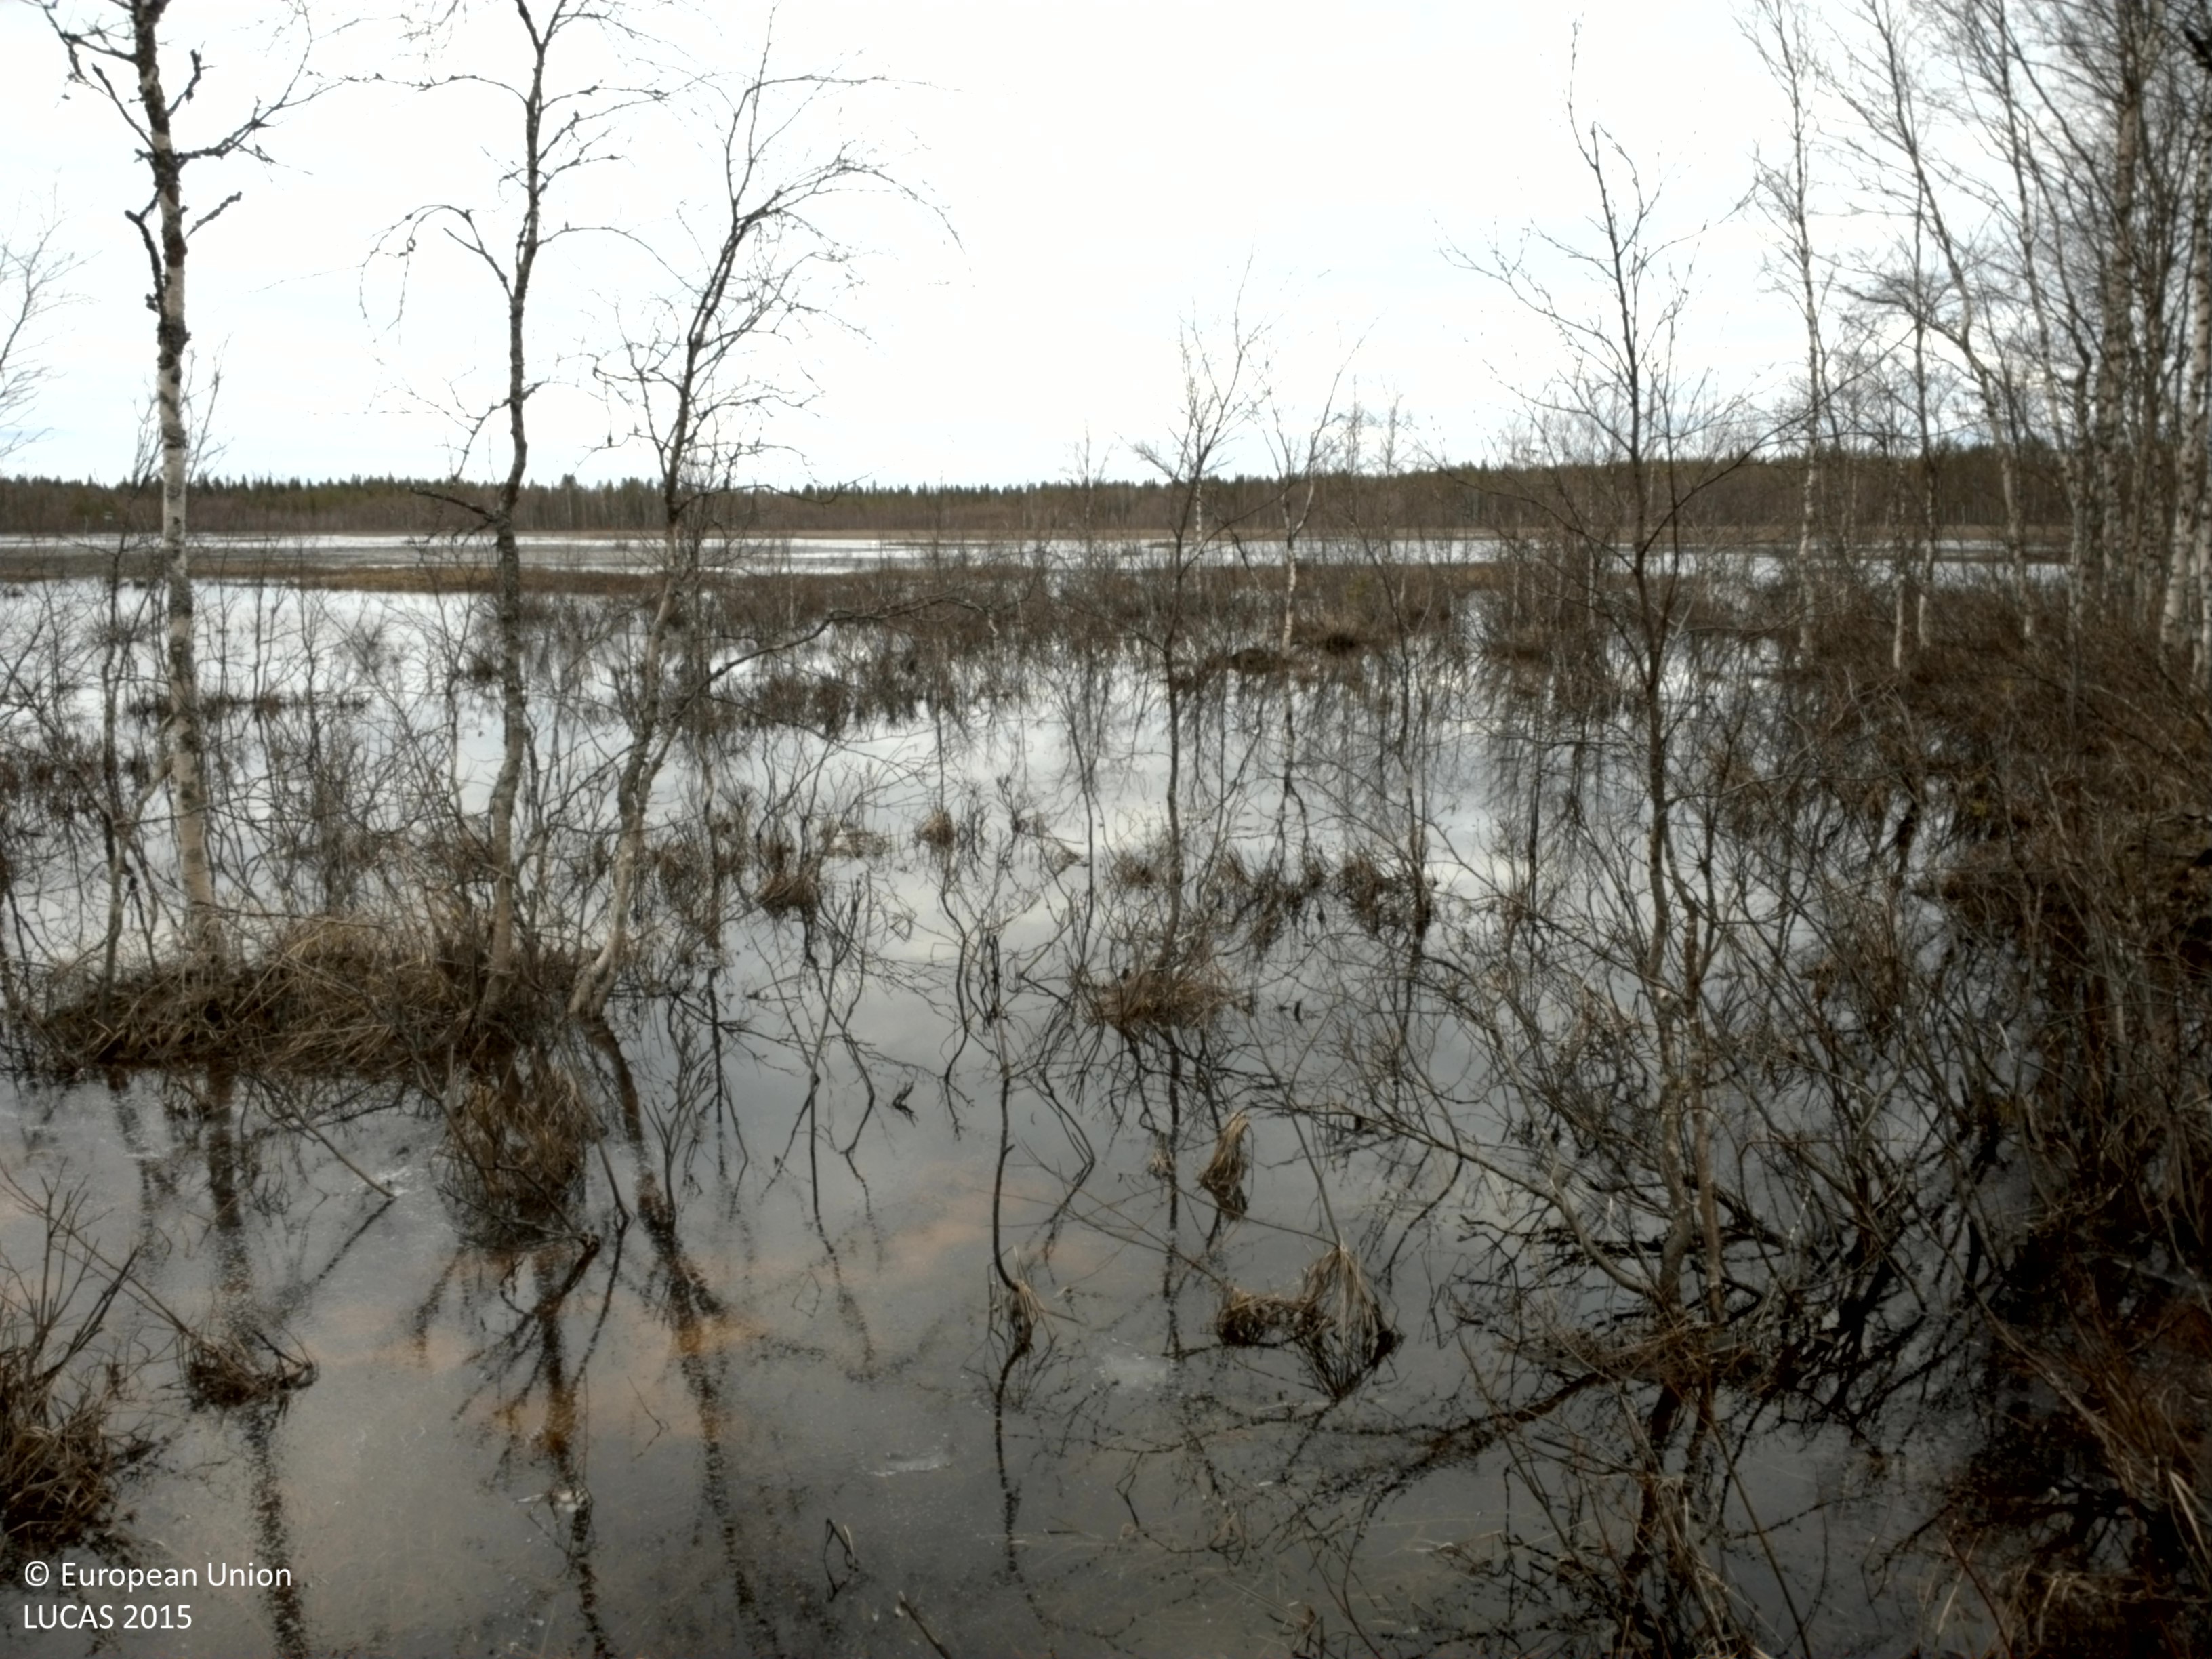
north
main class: Woodland
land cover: Broadleaved woodland
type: mire and swamp forests
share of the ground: 50 - 75 %
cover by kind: broadleaved forest trees 60 %, shrubs 15 %, herbaceous plants 10 %
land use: Semi-natural and natural areas not in use
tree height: > 5 m
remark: Temporary flooded
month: May
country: SE
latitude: 65.8939
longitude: 23.3086
